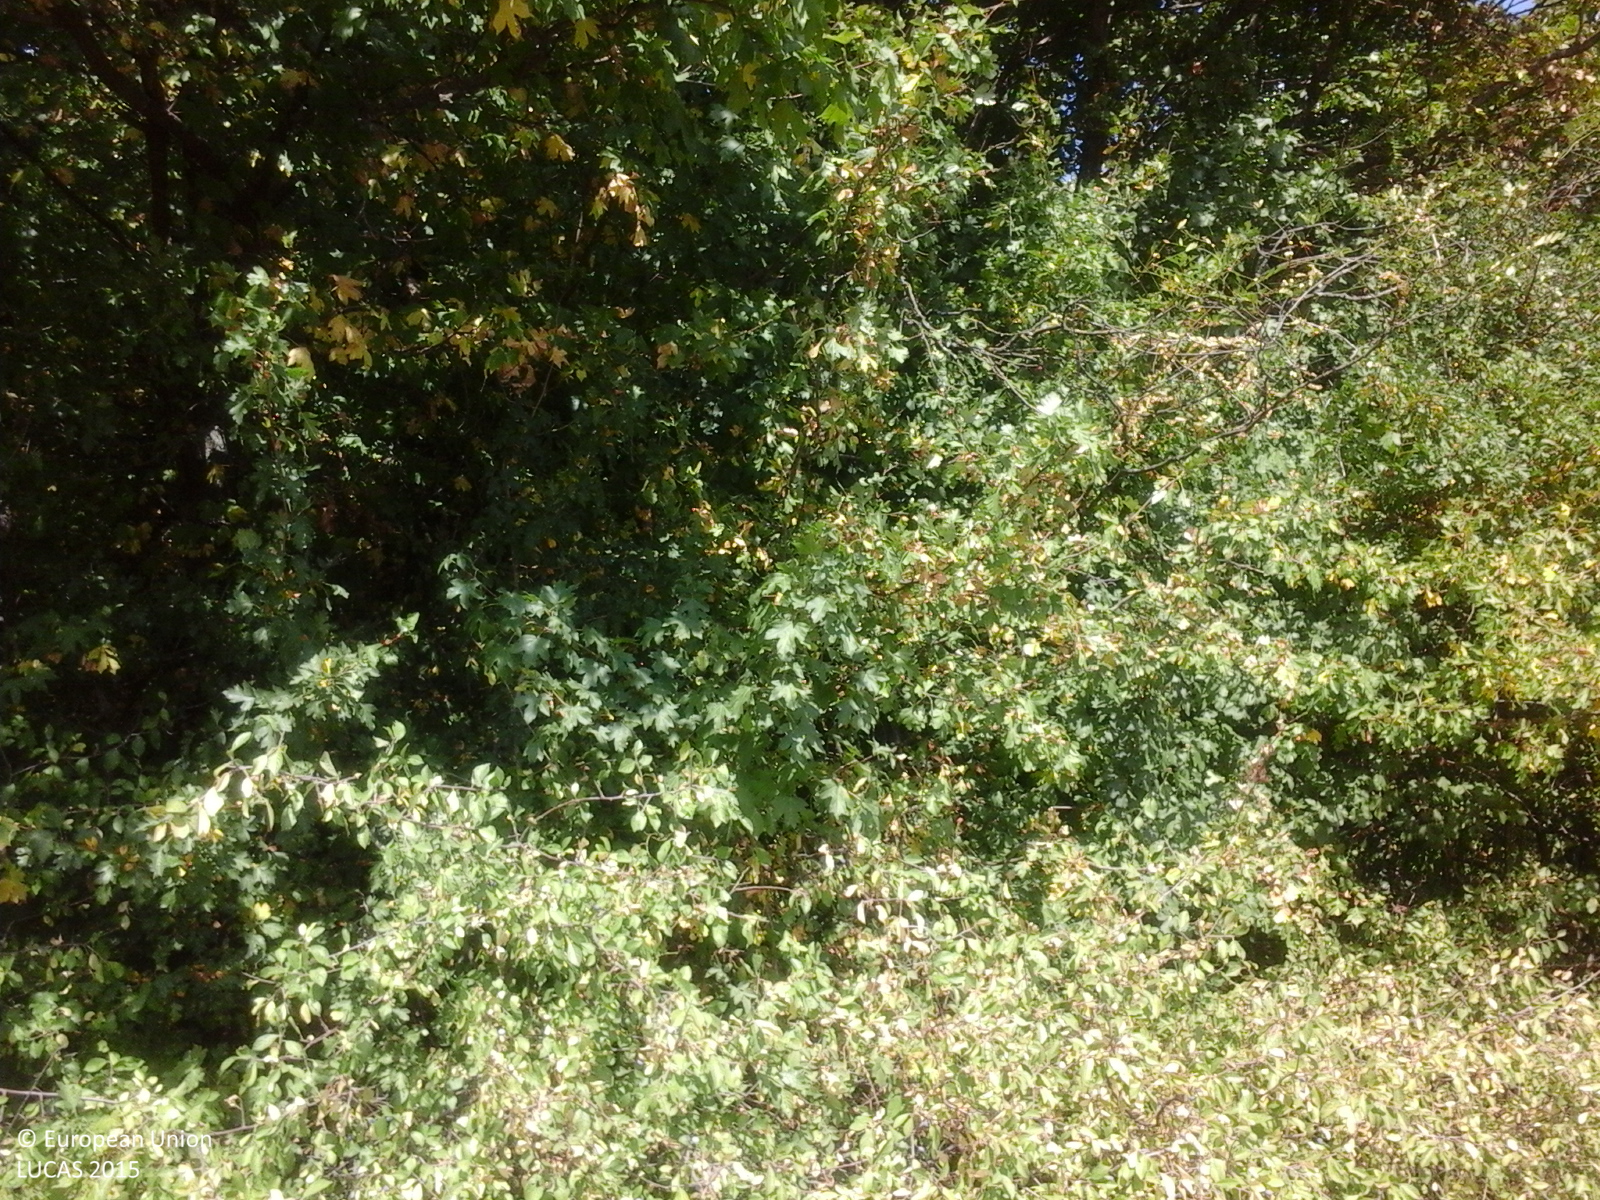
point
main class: Woodland
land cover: Broadleaved woodland
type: acidophilous oak and oak-birch forest
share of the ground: > 75 %
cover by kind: broadleaved forest trees 100 %
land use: Forestry
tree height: > 5 m
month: July
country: RO
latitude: 46.2093
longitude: 27.8905
